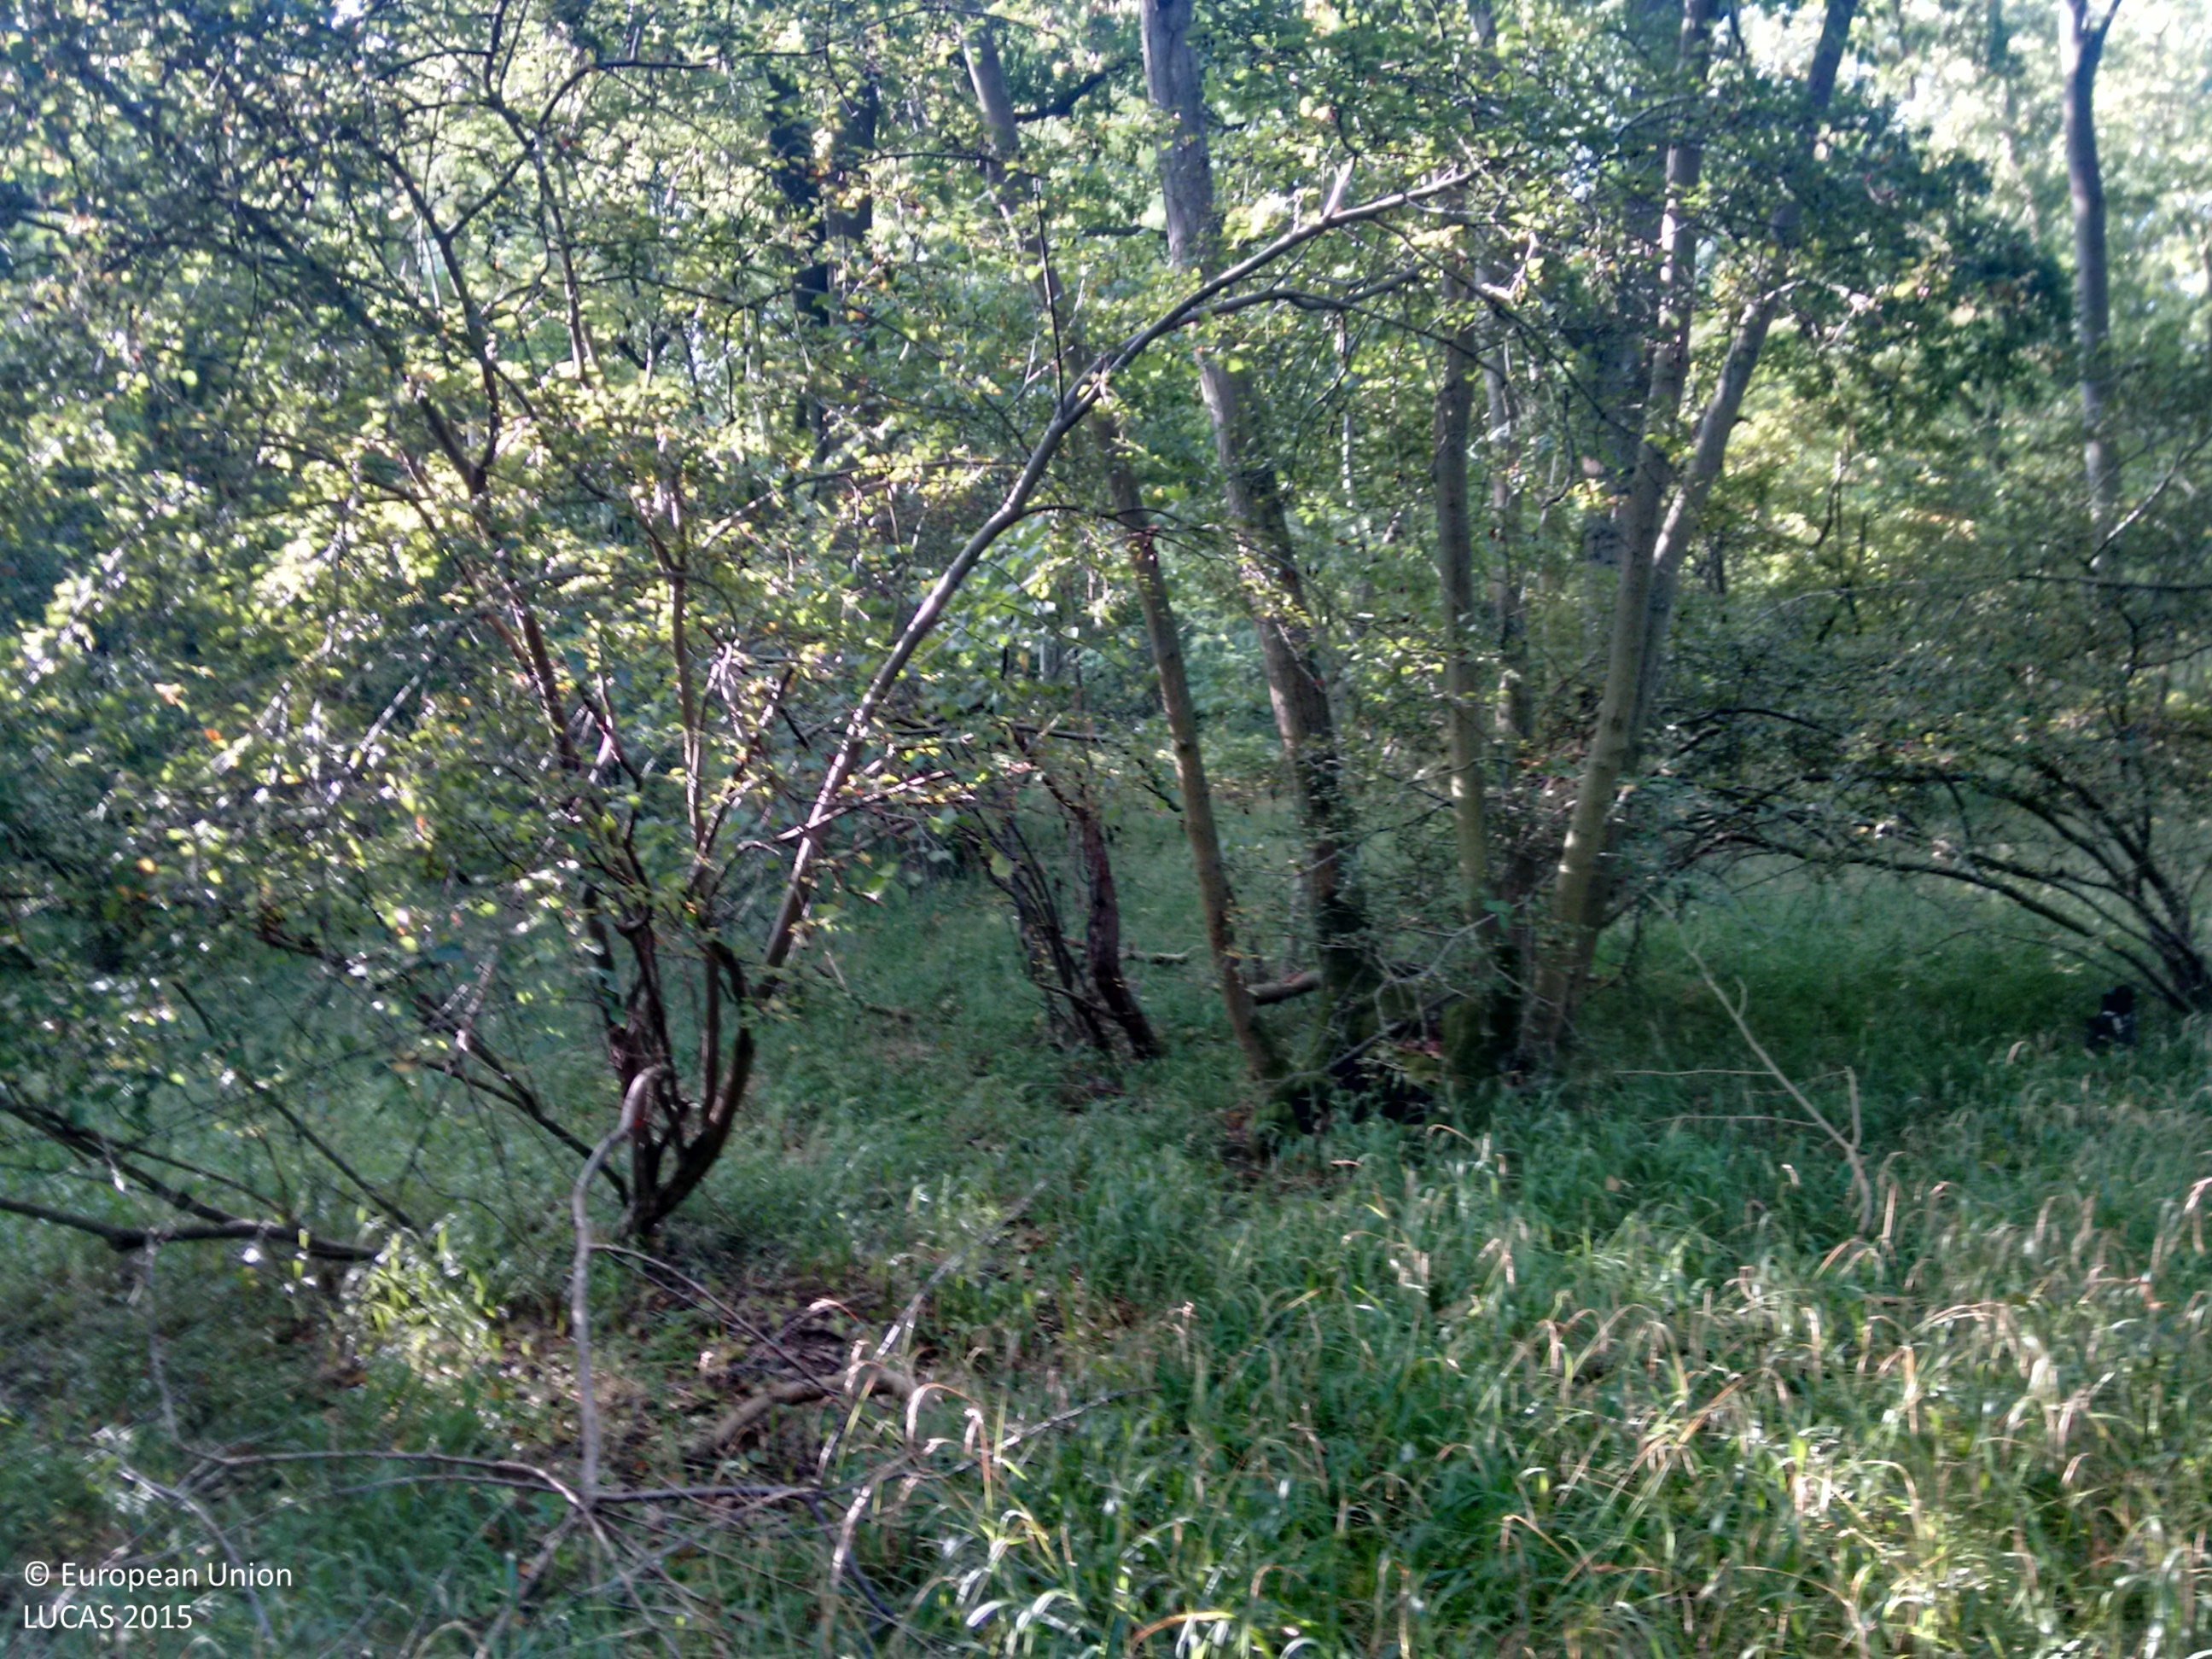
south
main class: Woodland
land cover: Broadleaved woodland
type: mesophytic deciduous forest
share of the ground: > 75 %
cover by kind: broadleaved forest trees 75 %, shrubs 25 %
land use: Amenities, museums, leisure
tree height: > 5 m
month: October
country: GB
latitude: 52.4038
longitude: -0.2509
